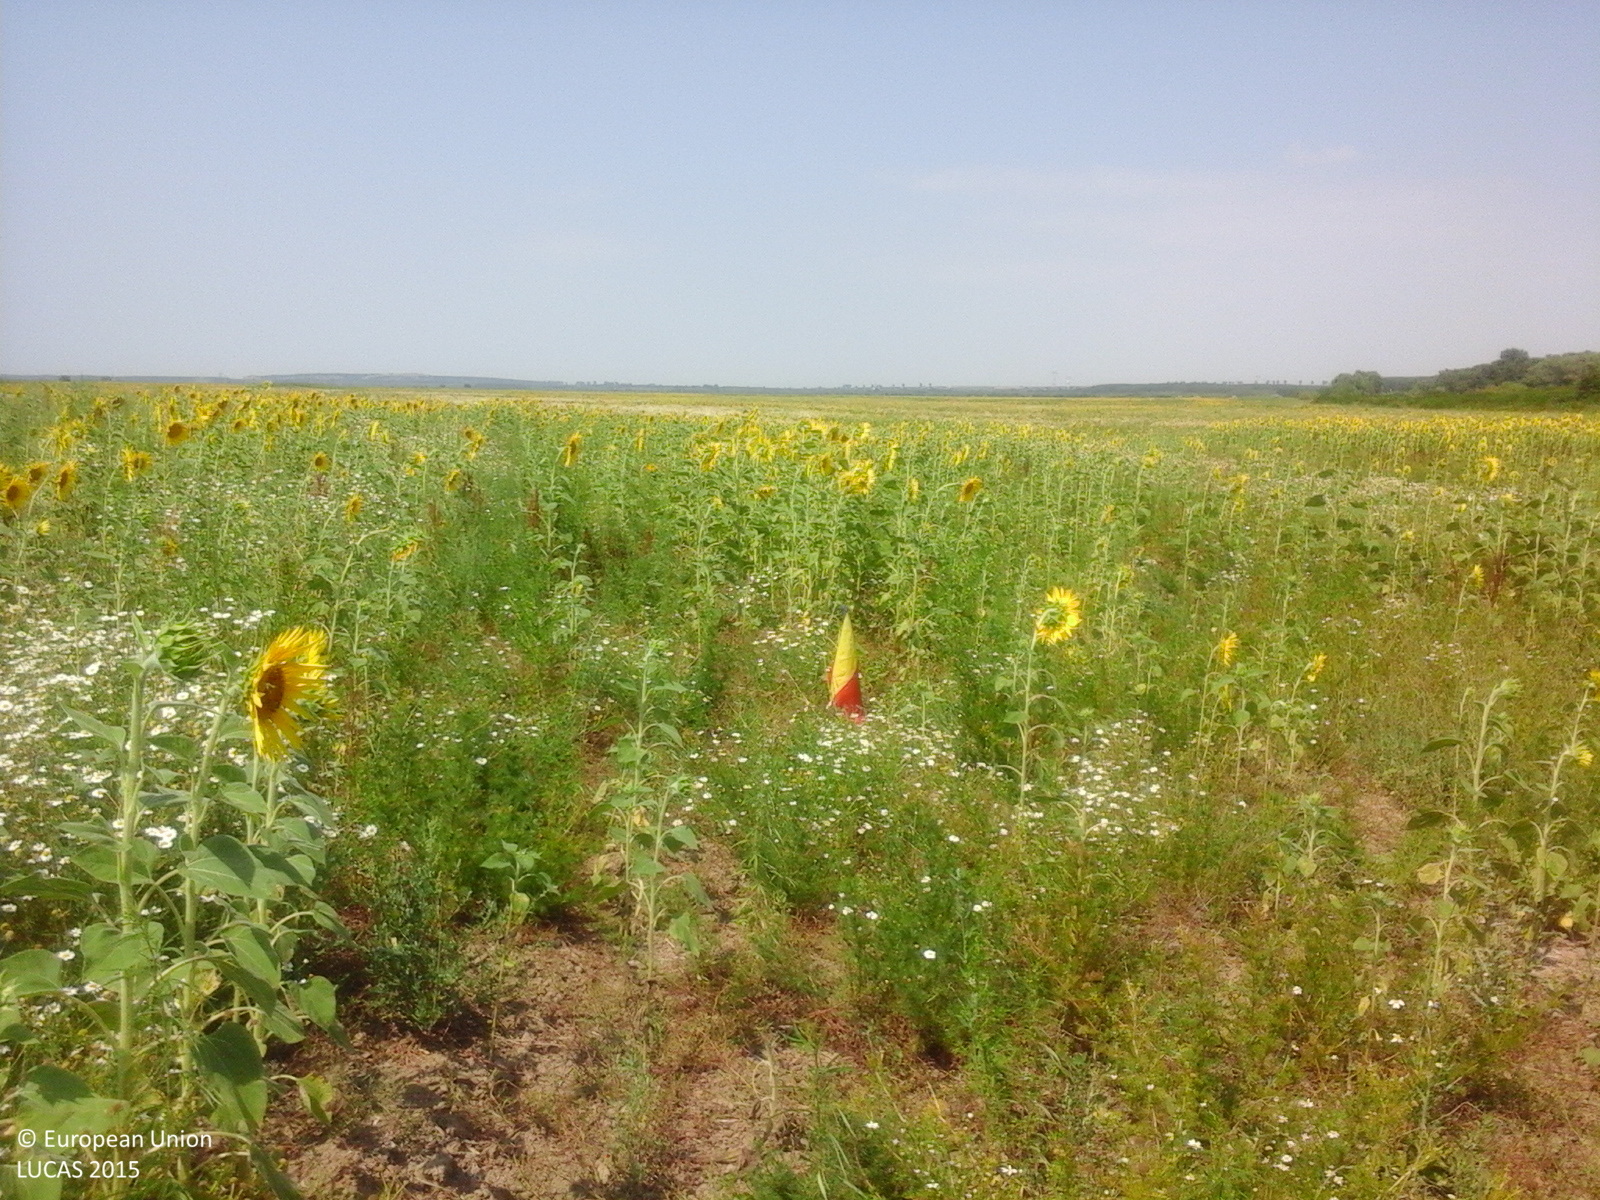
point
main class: Cropland
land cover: Sunflower
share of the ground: 50 - 75 %
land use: Agriculture (excluding fallow land and kitchen gardens)
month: July
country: RO
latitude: 44.5853
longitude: 28.0067
